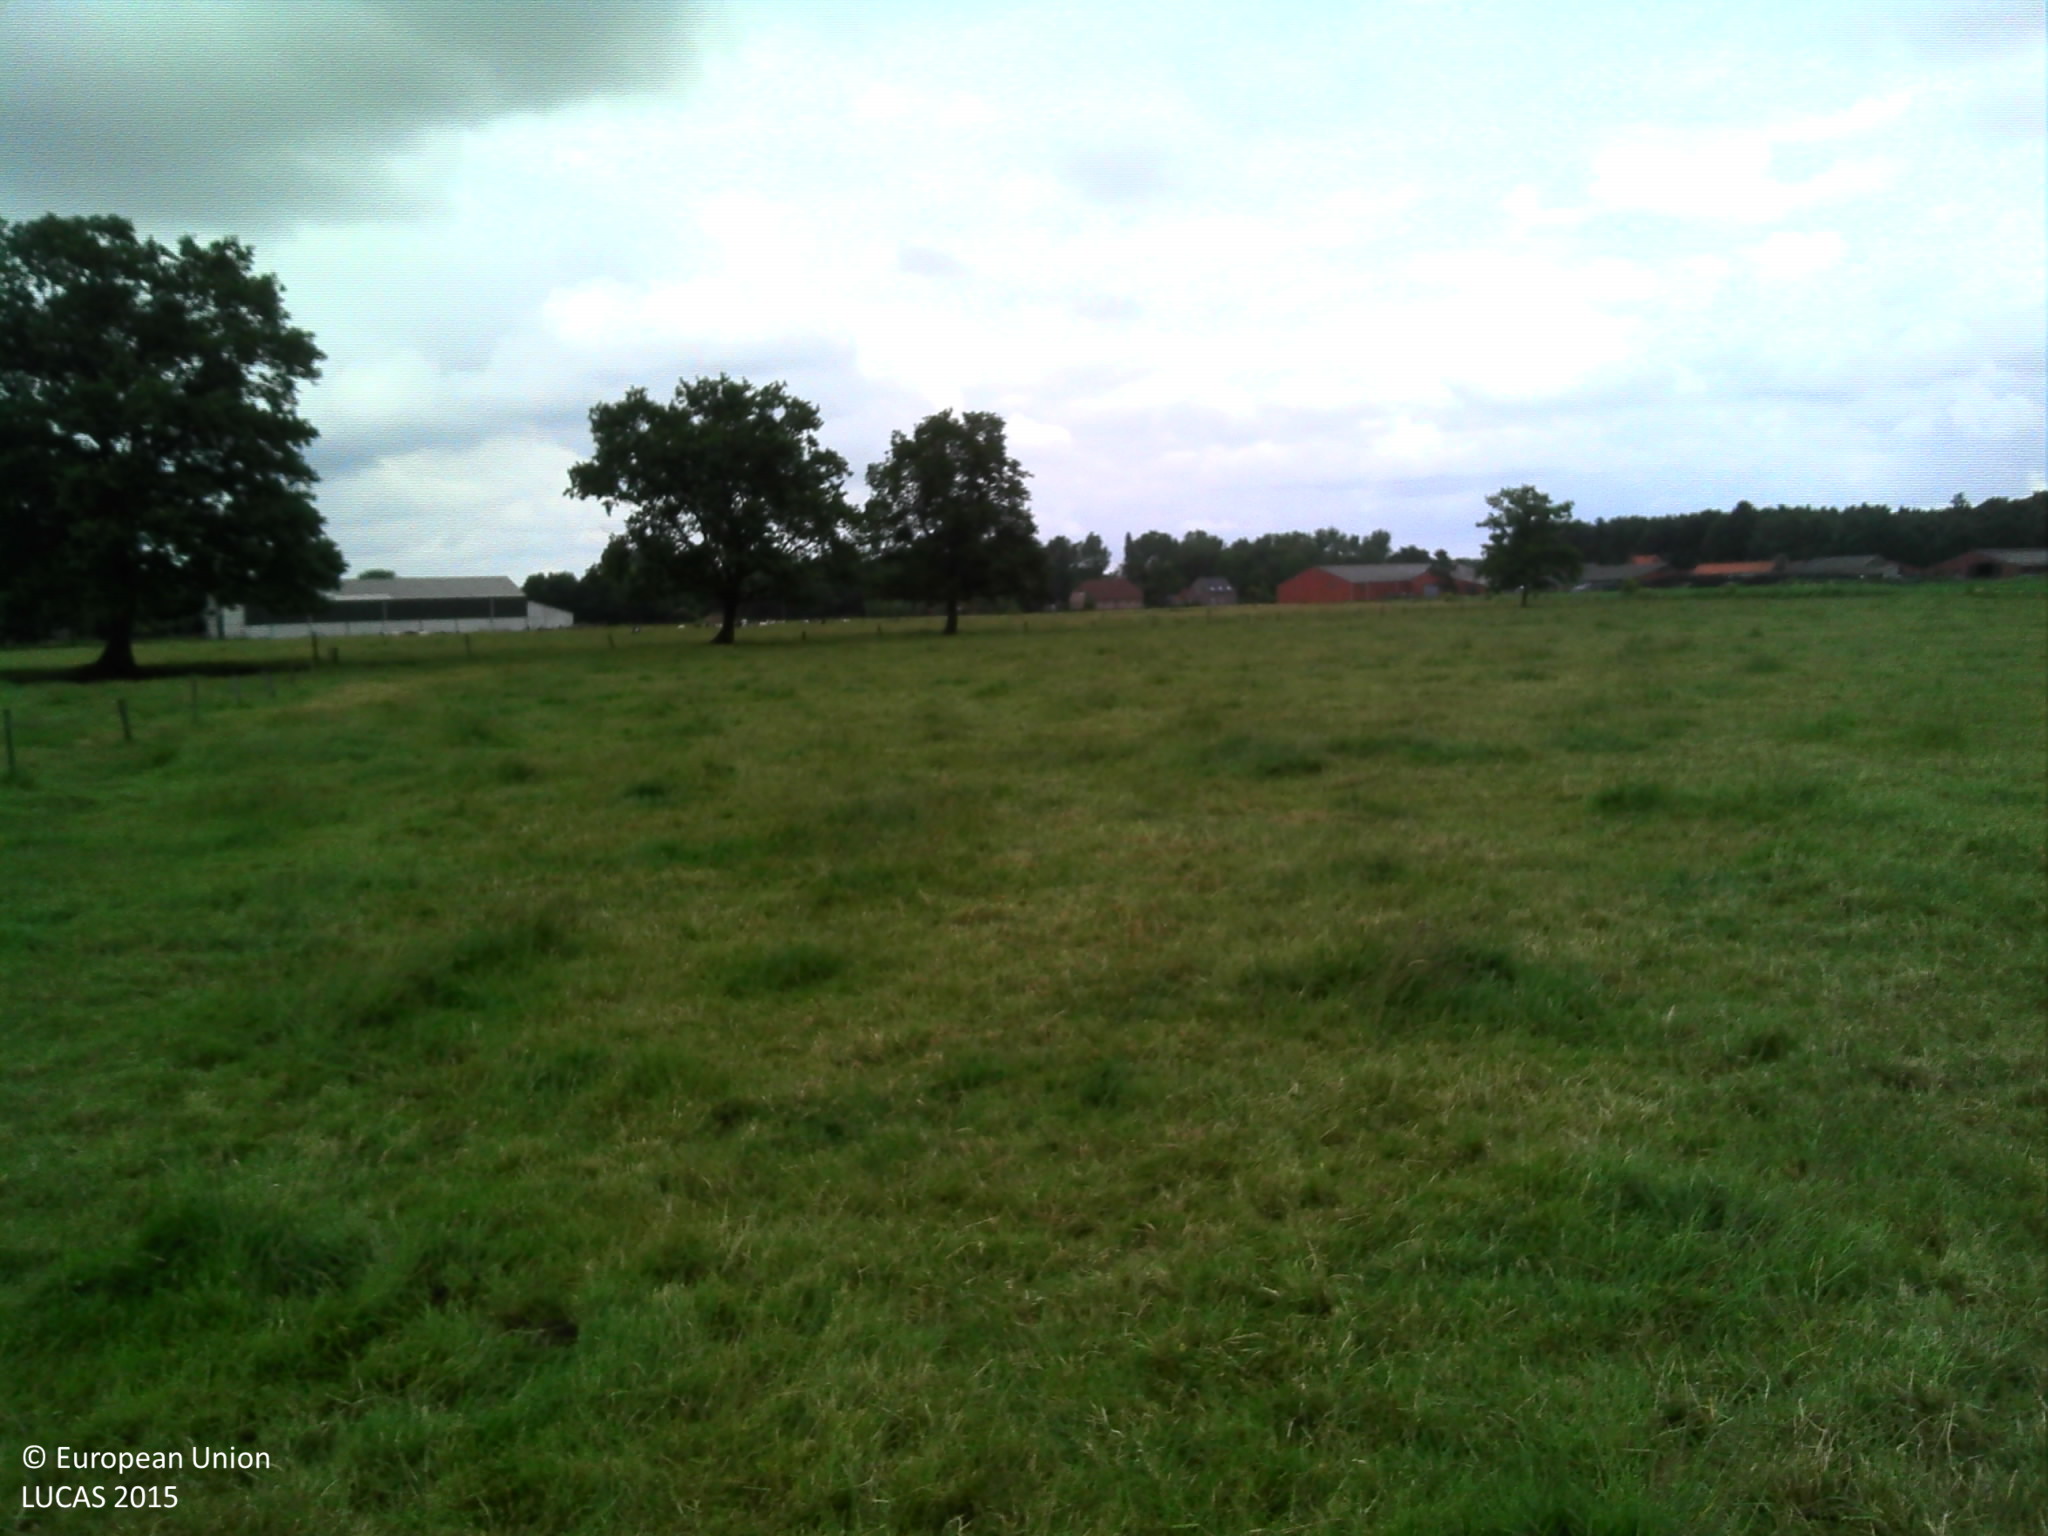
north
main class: Grassland
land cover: Grassland without tree/shrub cover
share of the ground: > 75 %
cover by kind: herbaceous plants 100 %
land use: Agriculture (excluding fallow land and kitchen gardens)
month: June
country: BE
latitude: 51.1951
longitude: 3.9408
